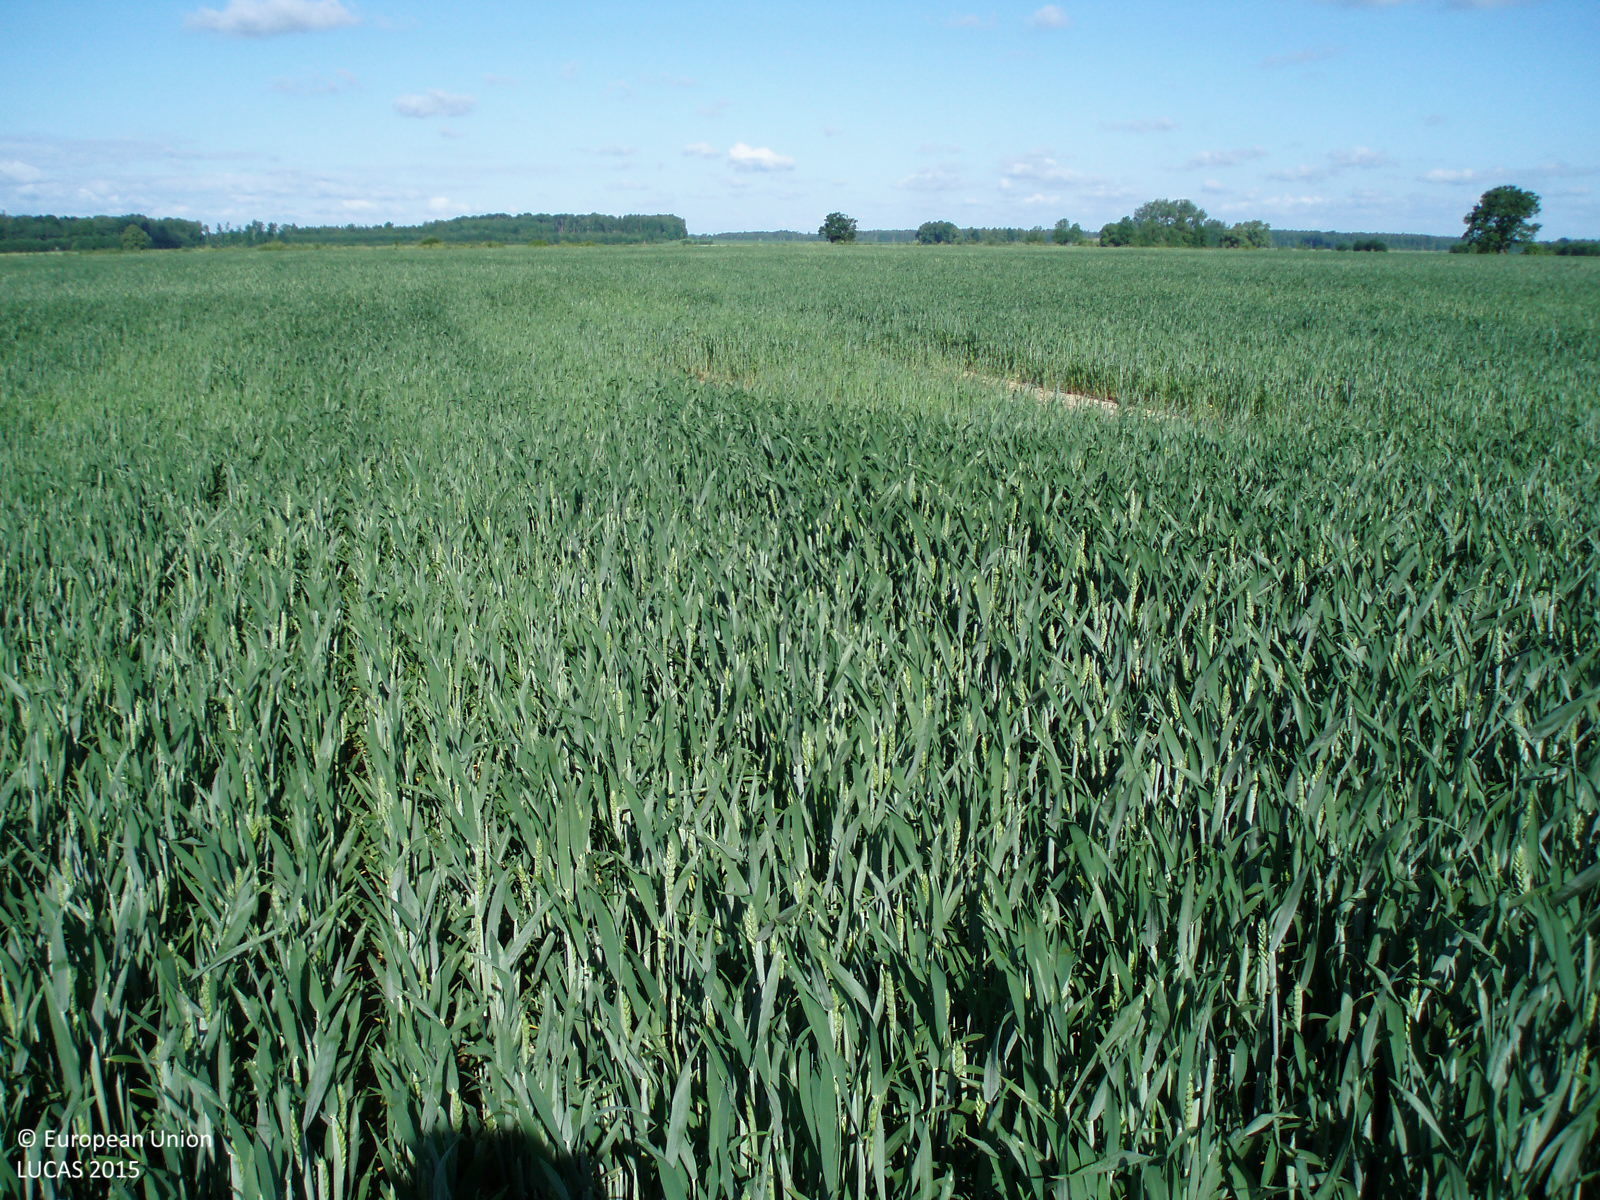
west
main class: Cropland
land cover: Common wheat
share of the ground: > 75 %
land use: Agriculture (excluding fallow land and kitchen gardens)
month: June
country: LT
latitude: 55.1994
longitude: 22.7769
